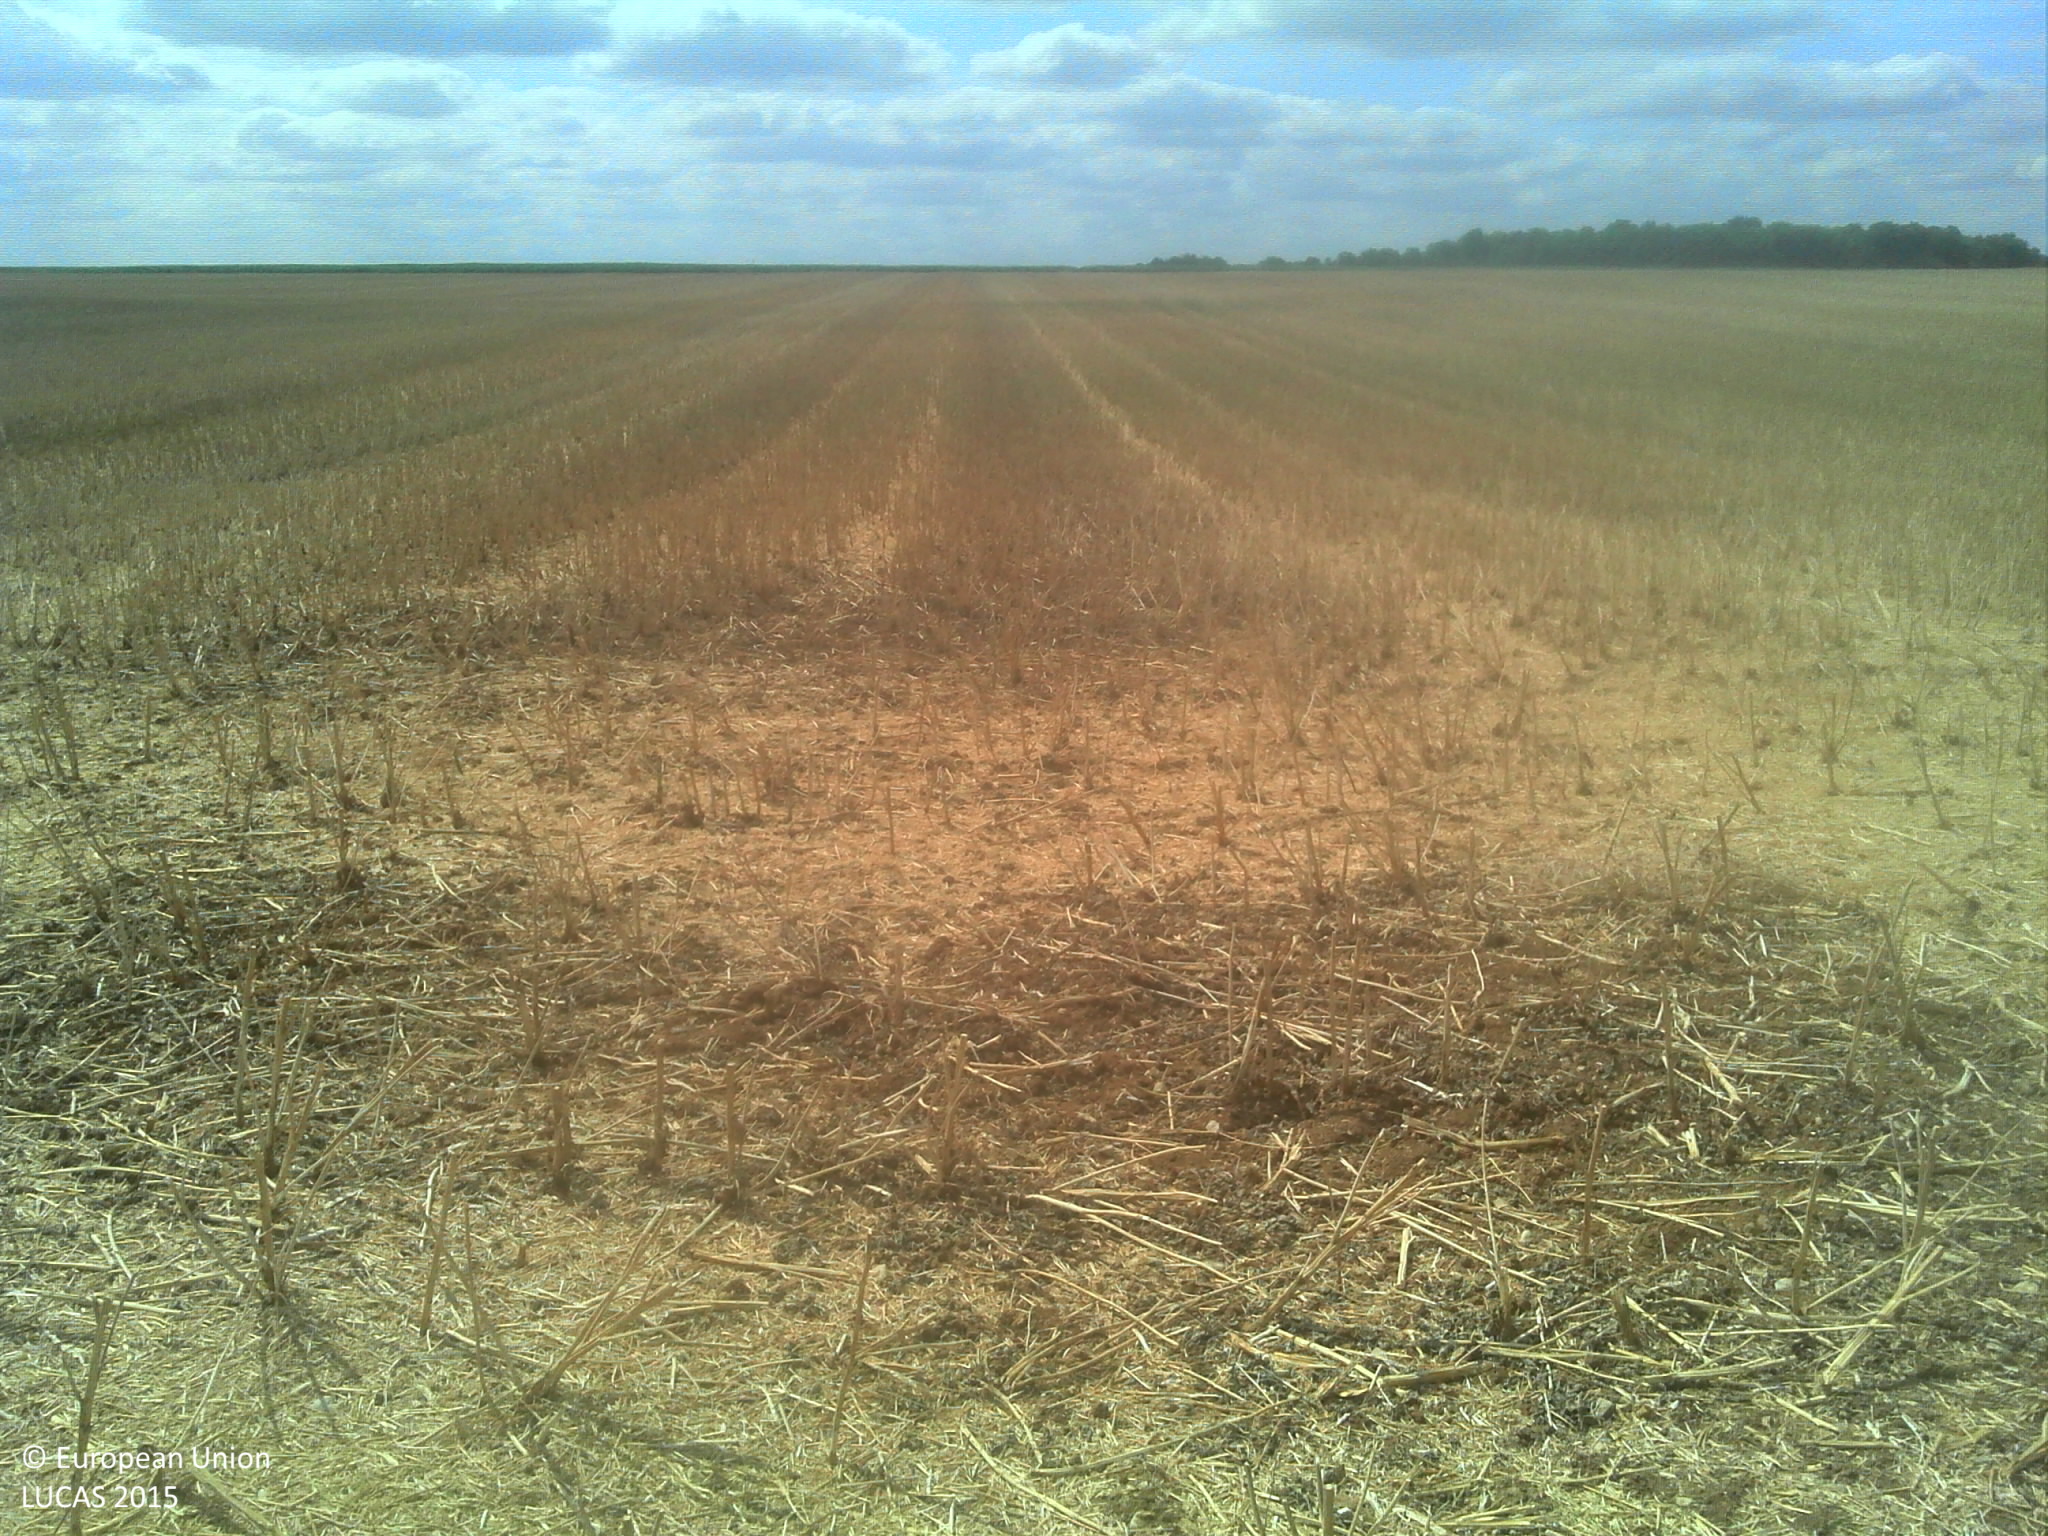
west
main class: Cropland
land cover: Rape and turnip rape
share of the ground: > 75 %
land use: Agriculture (excluding fallow land and kitchen gardens)
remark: Harvested field
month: July
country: FR
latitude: 47.9530
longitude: 1.3197
